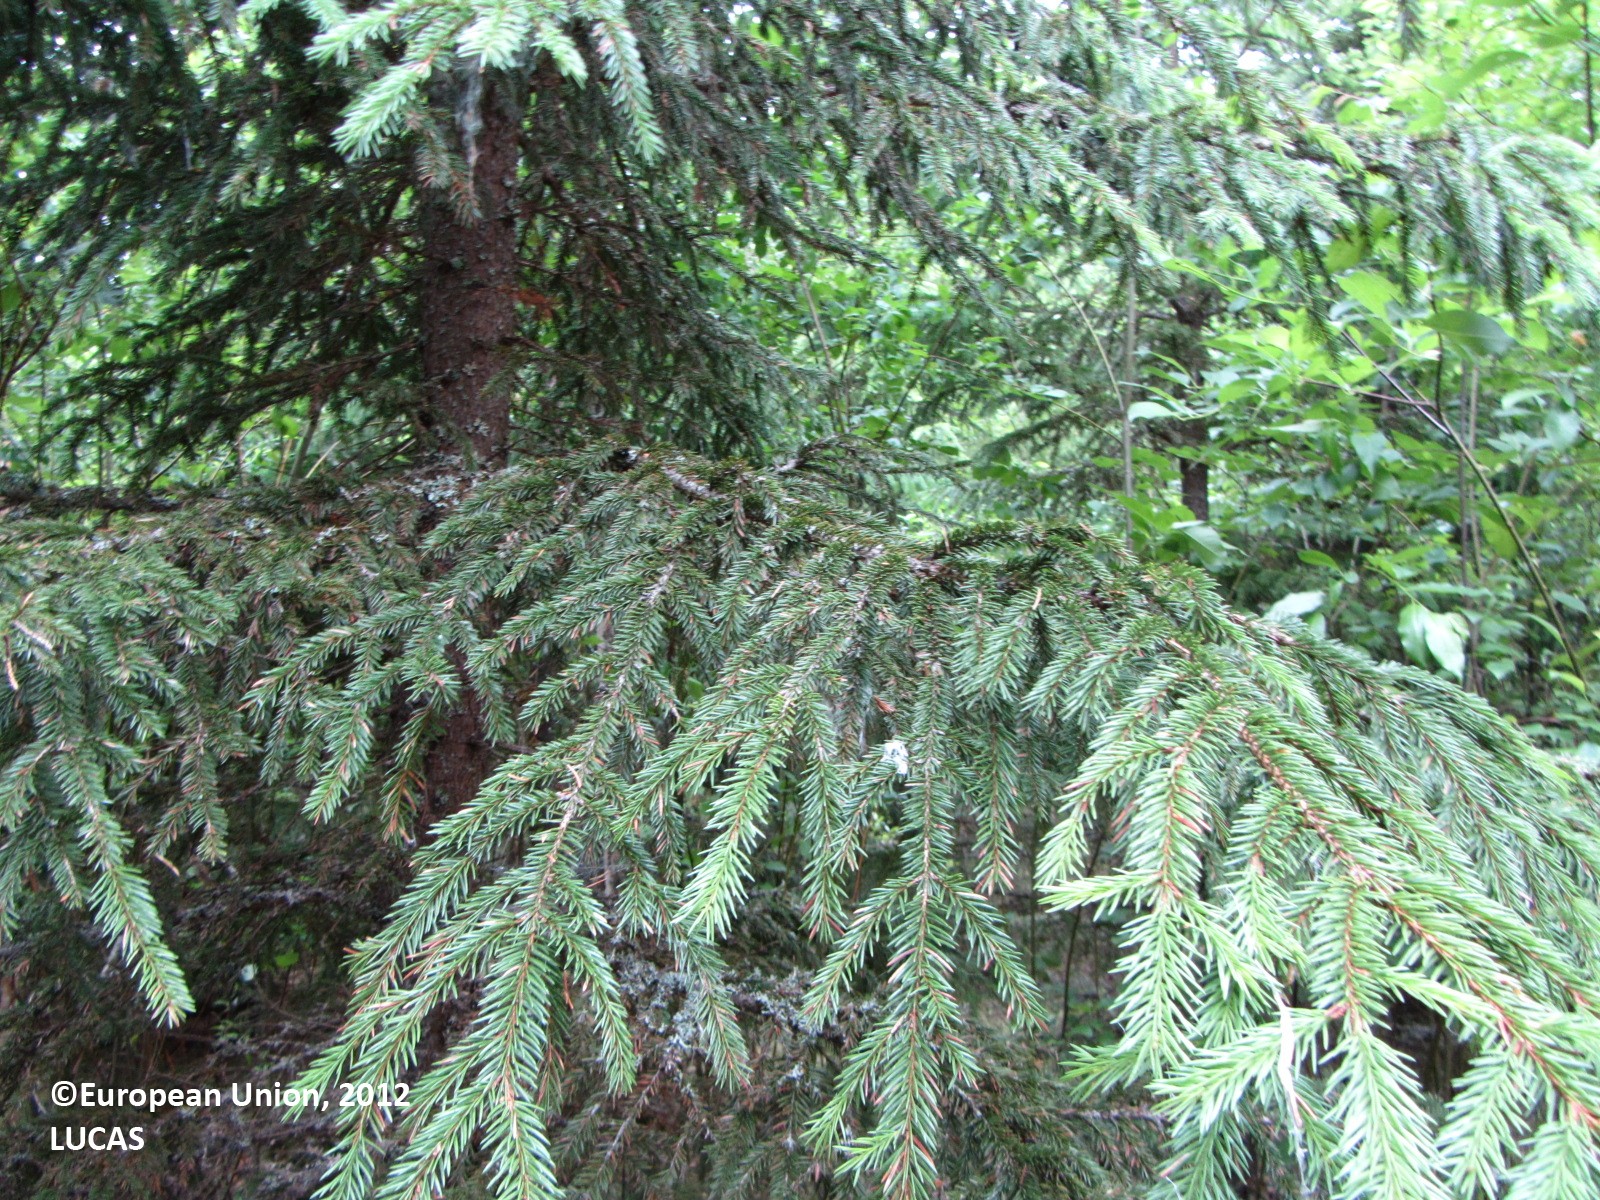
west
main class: Woodland
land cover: Spruce dominated mixed woodland
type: boreal forest
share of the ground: > 75 %
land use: Forestry
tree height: > 5 m
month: June
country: FI
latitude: 62.6211
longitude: 25.6090
